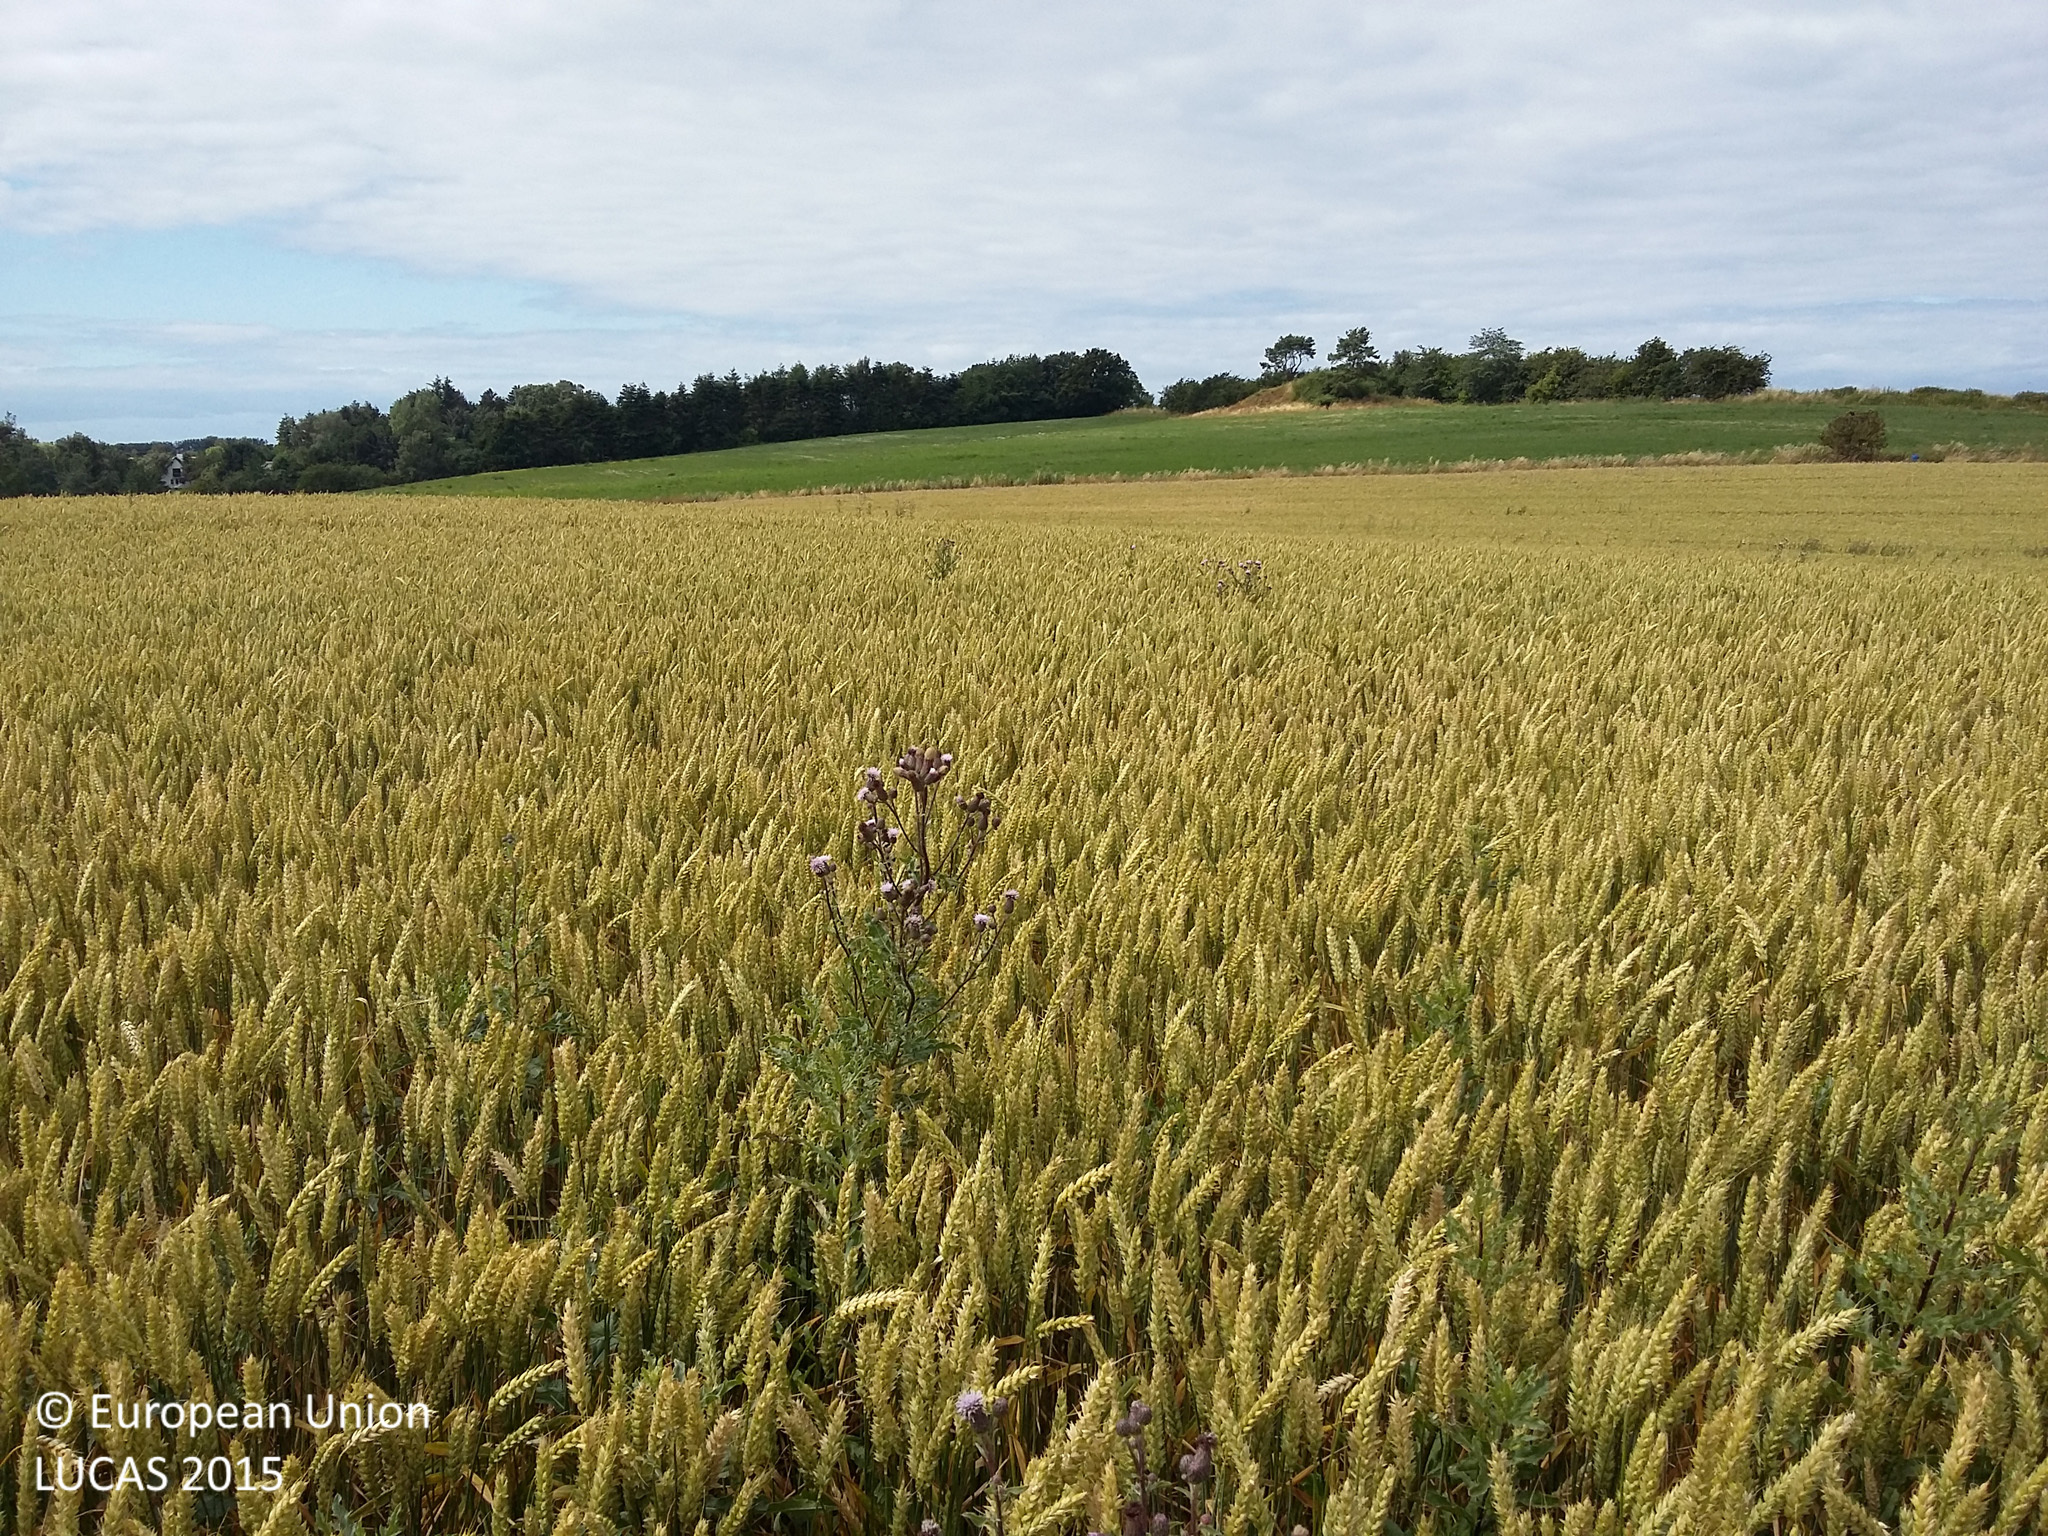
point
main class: Cropland
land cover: Common wheat
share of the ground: > 75 %
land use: Agriculture (excluding fallow land and kitchen gardens)
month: July
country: DK
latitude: 56.0257
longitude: 12.1640
